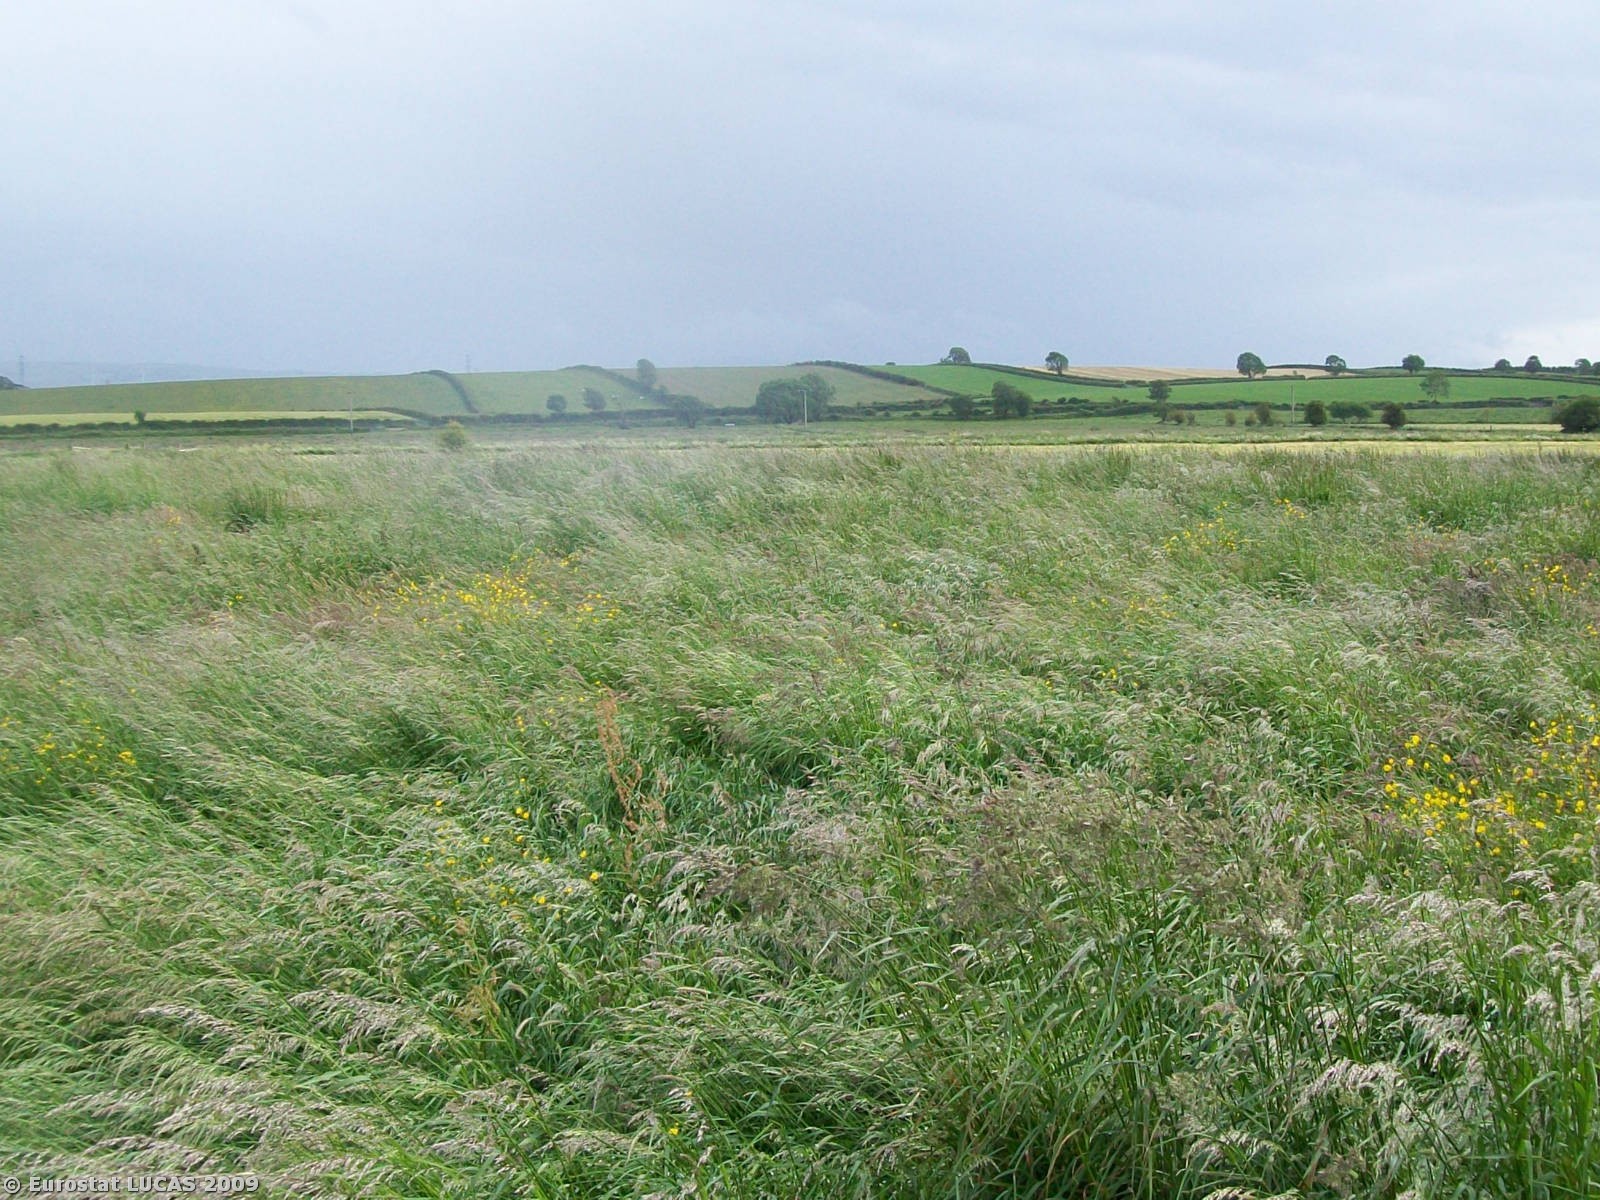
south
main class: Grassland
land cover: Grassland without tree/shrub cover
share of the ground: > 75 %
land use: Agriculture (excluding fallow land and kitchen gardens)
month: June
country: GB
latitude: 54.8448
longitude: -3.2033
